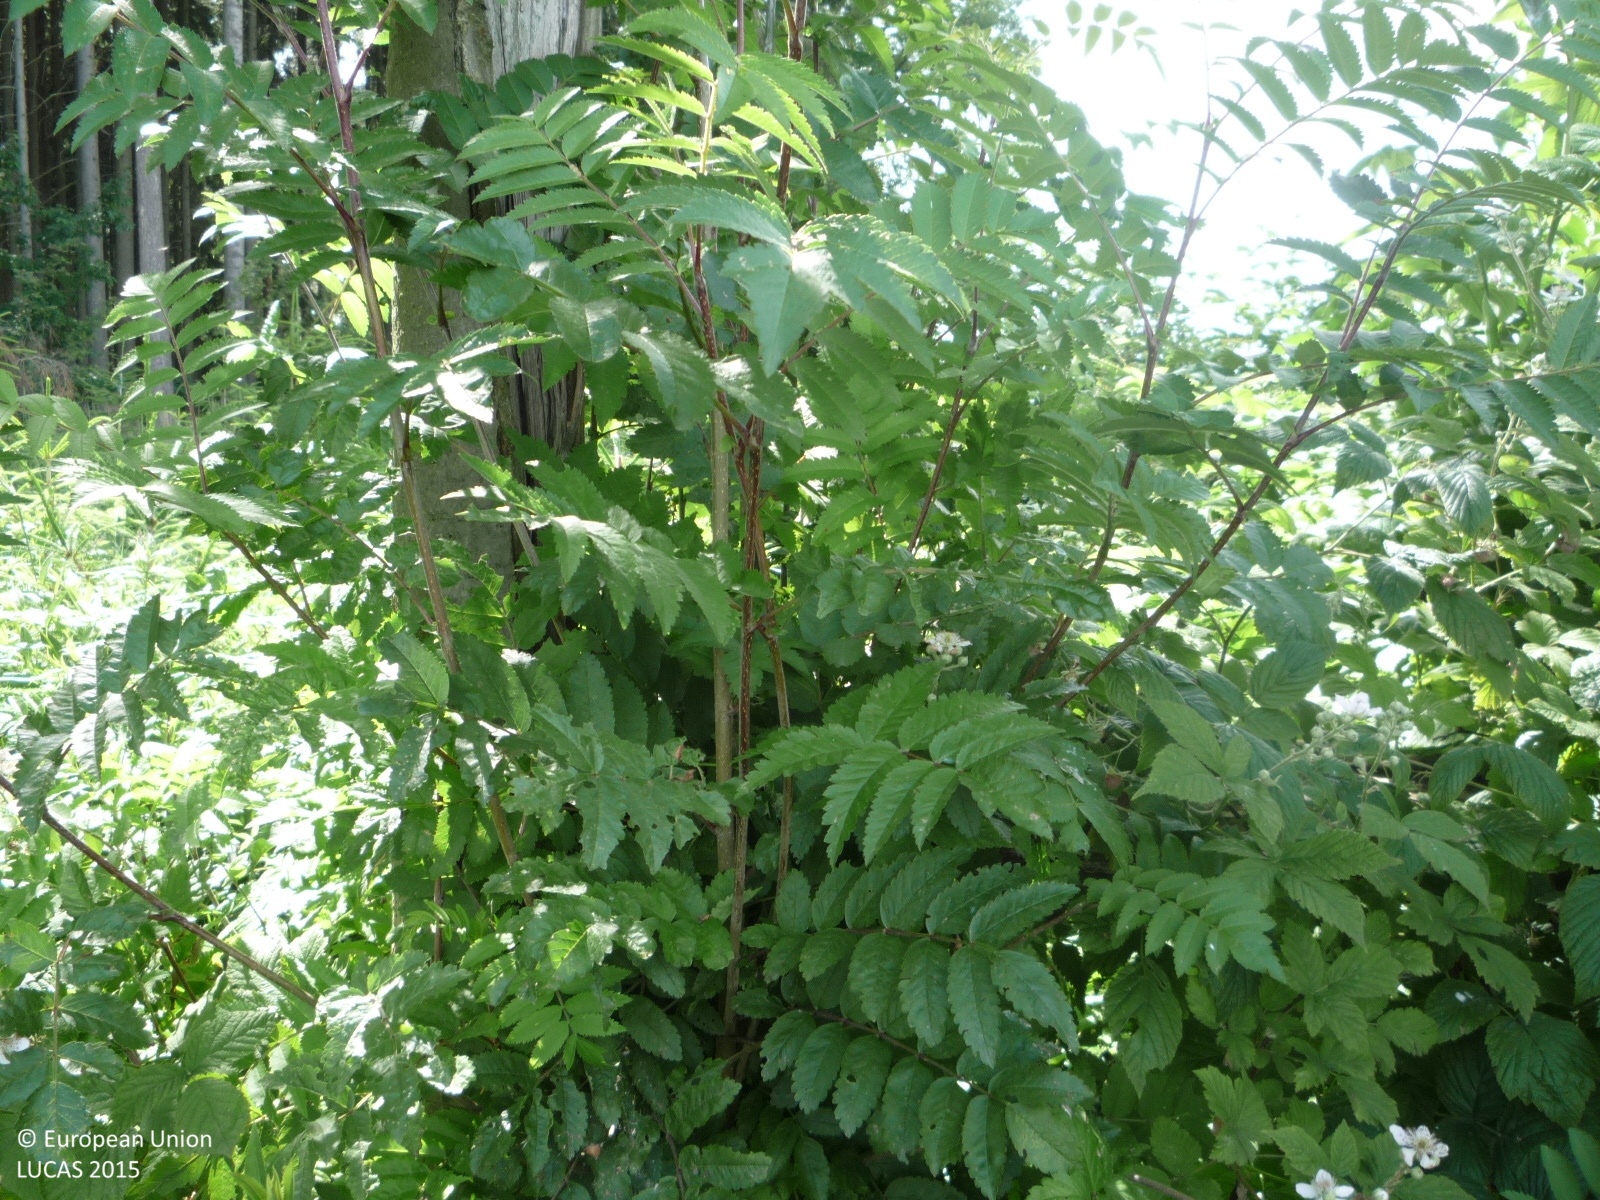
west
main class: Woodland
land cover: Spruce dominated coniferous woodland
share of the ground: 25 - 50 %
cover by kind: coniferous forest trees 40 %, herbaceous plants 40 %, shrubs 20 %
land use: Forestry
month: June
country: CZ
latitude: 49.9389
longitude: 15.5915
